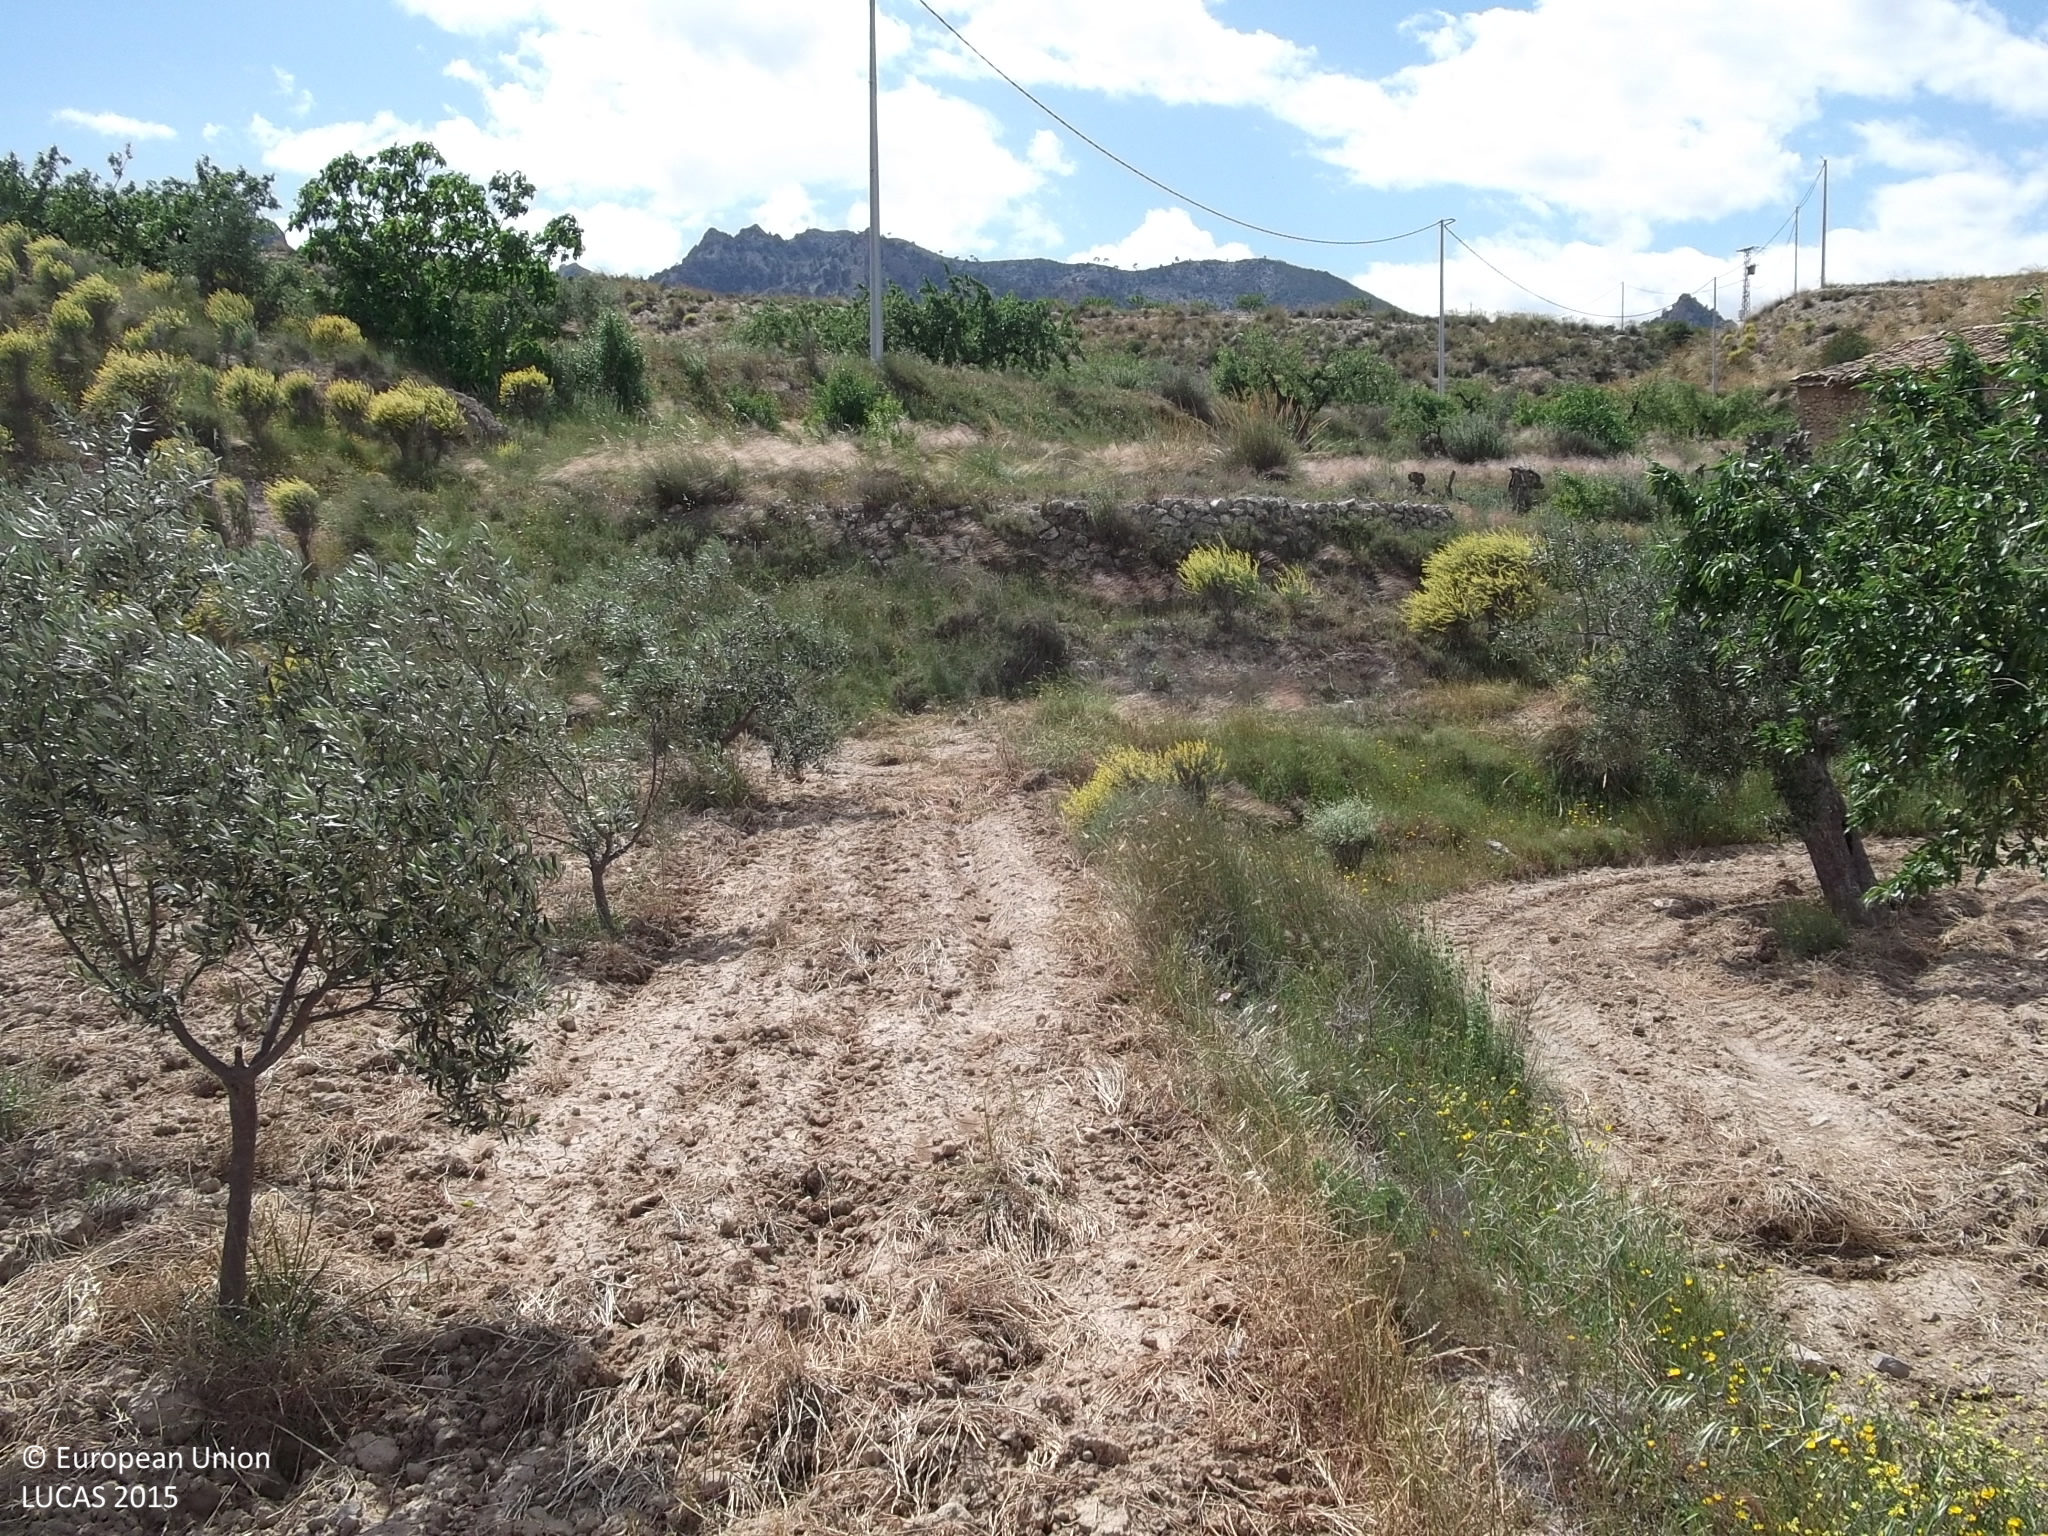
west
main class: Cropland
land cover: Olive groves
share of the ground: 10 - 25 %
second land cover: Other bare soil
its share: > 75 %
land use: Agriculture (excluding fallow land and kitchen gardens)
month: April
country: ES
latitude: 38.1586
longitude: -1.3884
